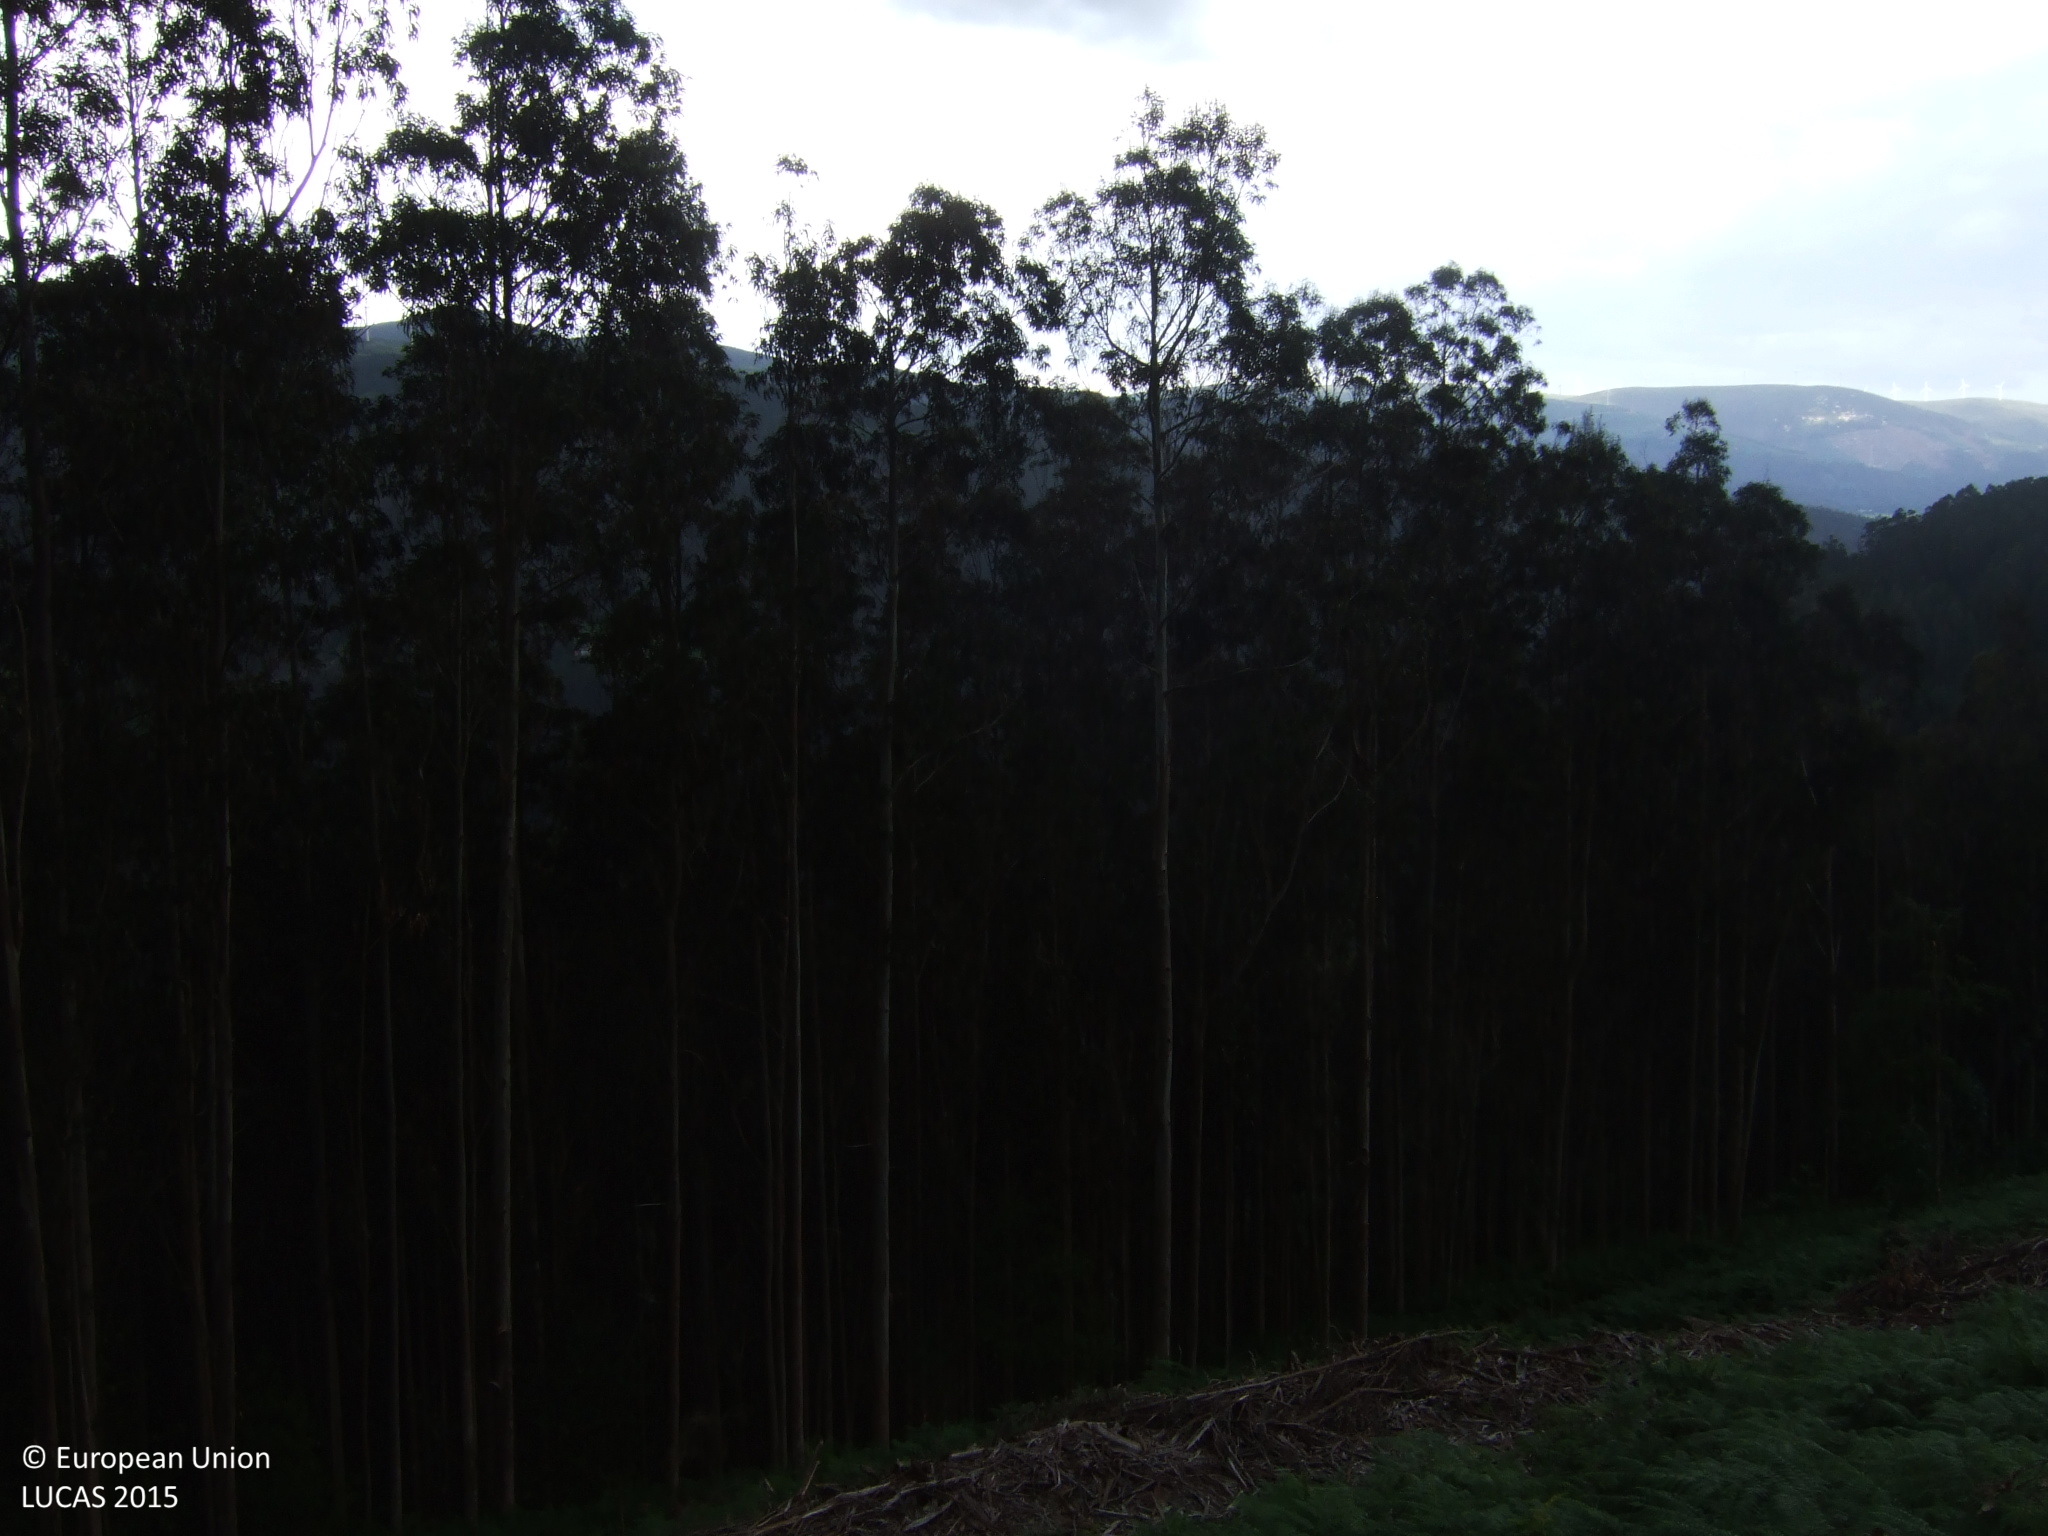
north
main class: Grassland
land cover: Spontaneously vegetated surfaces
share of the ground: 50 - 75 %
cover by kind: herbaceous plants 50 %, unconsolidated bare surface 50 %
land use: Forestry
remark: Clear cut
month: June
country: ES
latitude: 43.4973
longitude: -7.4813
